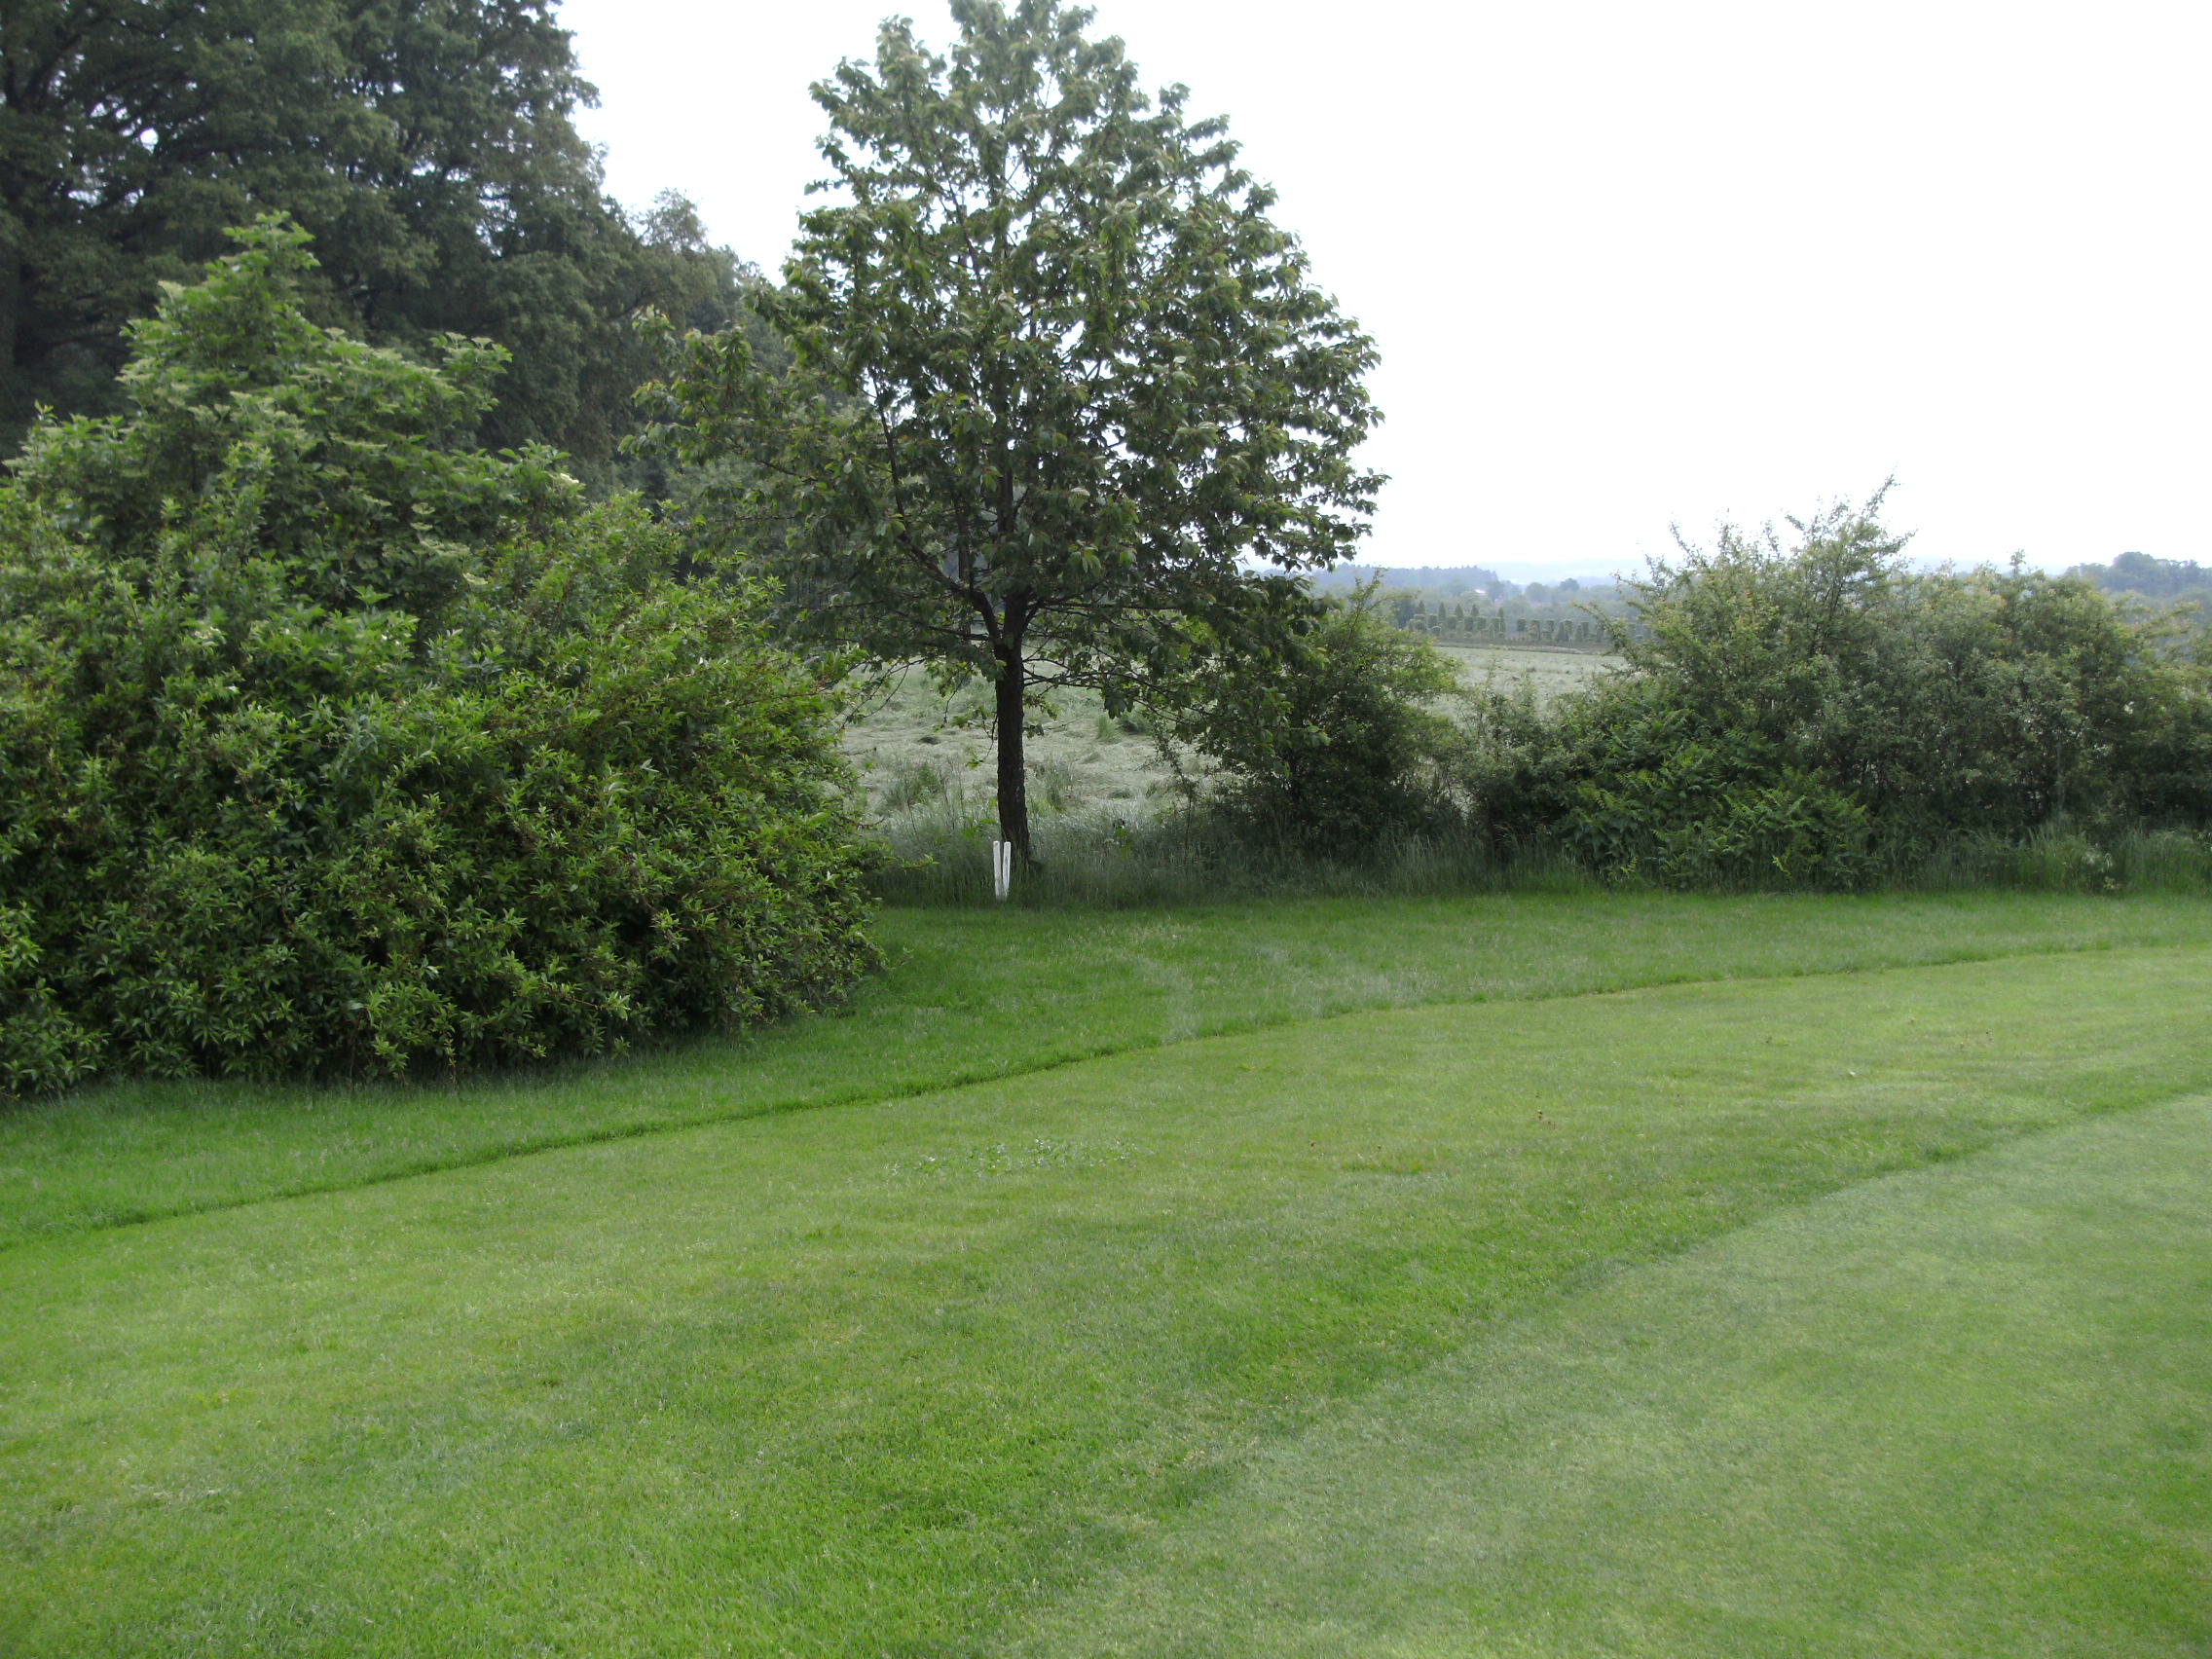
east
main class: Grassland
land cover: Grassland without tree/shrub cover
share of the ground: > 75 %
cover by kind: herbaceous plants 100 %
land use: Sport
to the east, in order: Grassland without tree/shrub cover; Grassland with sparse tree/shrub cover; Grassland without tree/shrub cover; Ditches and canals; Grassland without tree/shrub cover; Paved roads, cycling and walking lanes; Grass margins; Ditches and canals; Grassland without tree/shrub cover
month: May
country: AT
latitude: 48.3834
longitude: 13.5237
